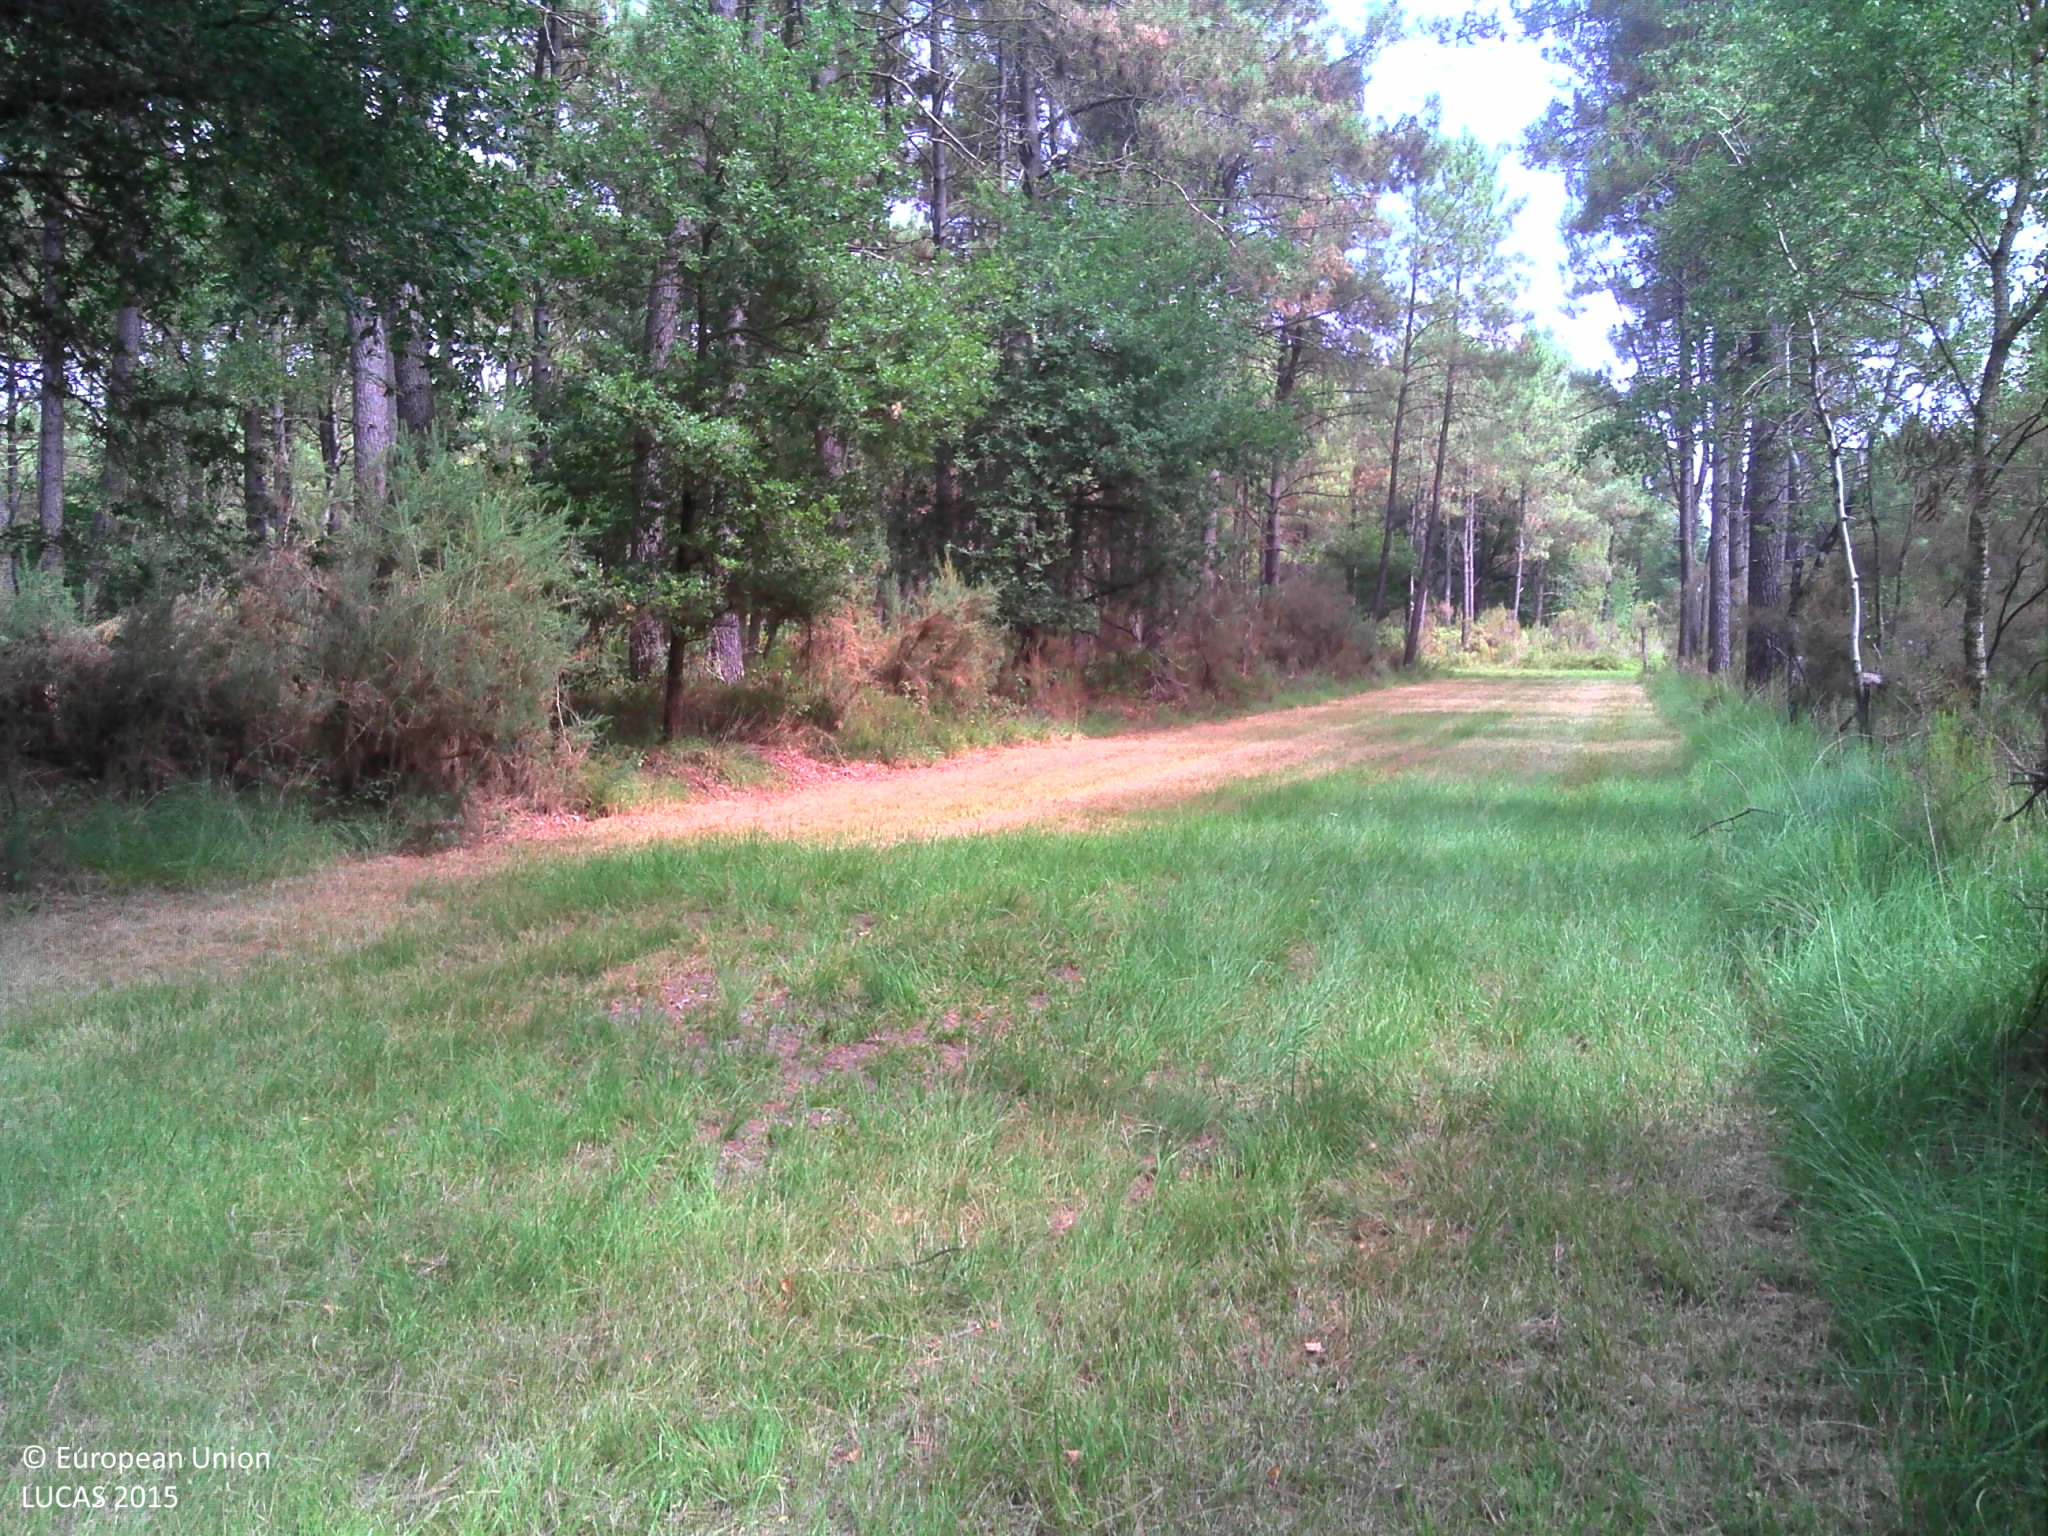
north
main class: Woodland
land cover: Pine dominated coniferous woodland
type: exotic forest
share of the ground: > 75 %
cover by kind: coniferous forest trees 55 %, herbaceous plants 20 %, broadleaved forest trees 10 %, shrubs 10 %, lichens and mosses 5 %
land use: Forestry
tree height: > 5 m
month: August
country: FR
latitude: 47.1815
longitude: 0.3322
